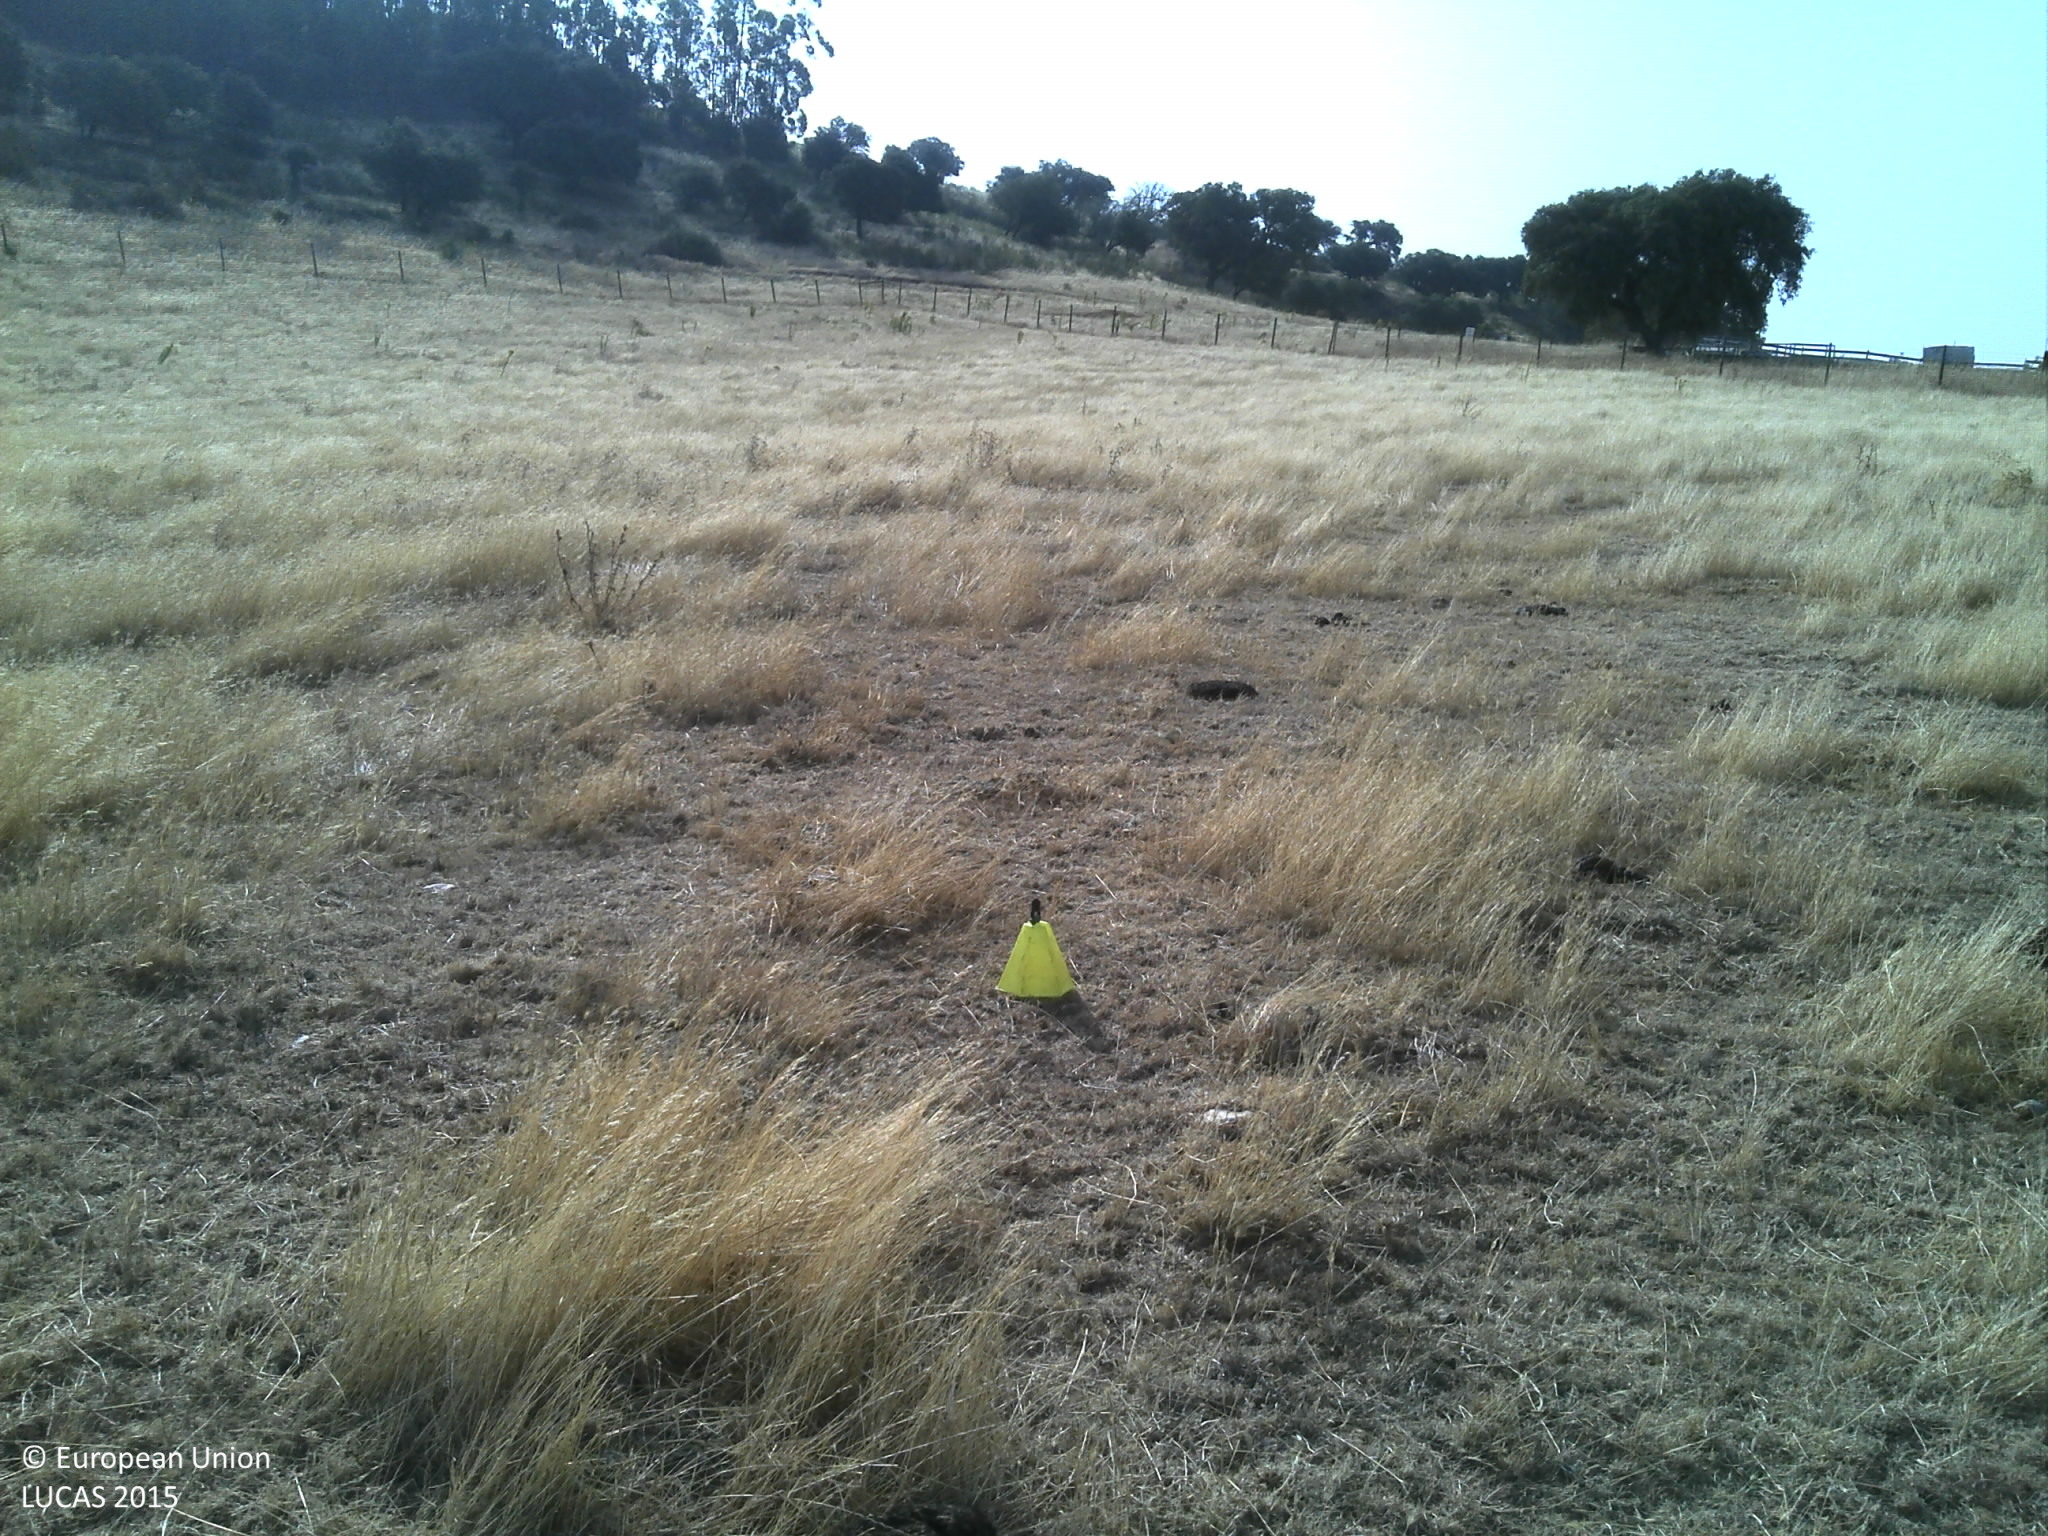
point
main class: Grassland
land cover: Grassland without tree/shrub cover
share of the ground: 25 - 50 %
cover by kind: unconsolidated bare surface 60 %, herbaceous plants 40 %
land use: Agriculture (excluding fallow land and kitchen gardens)
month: July
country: PT
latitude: 38.7077
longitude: -7.4531
